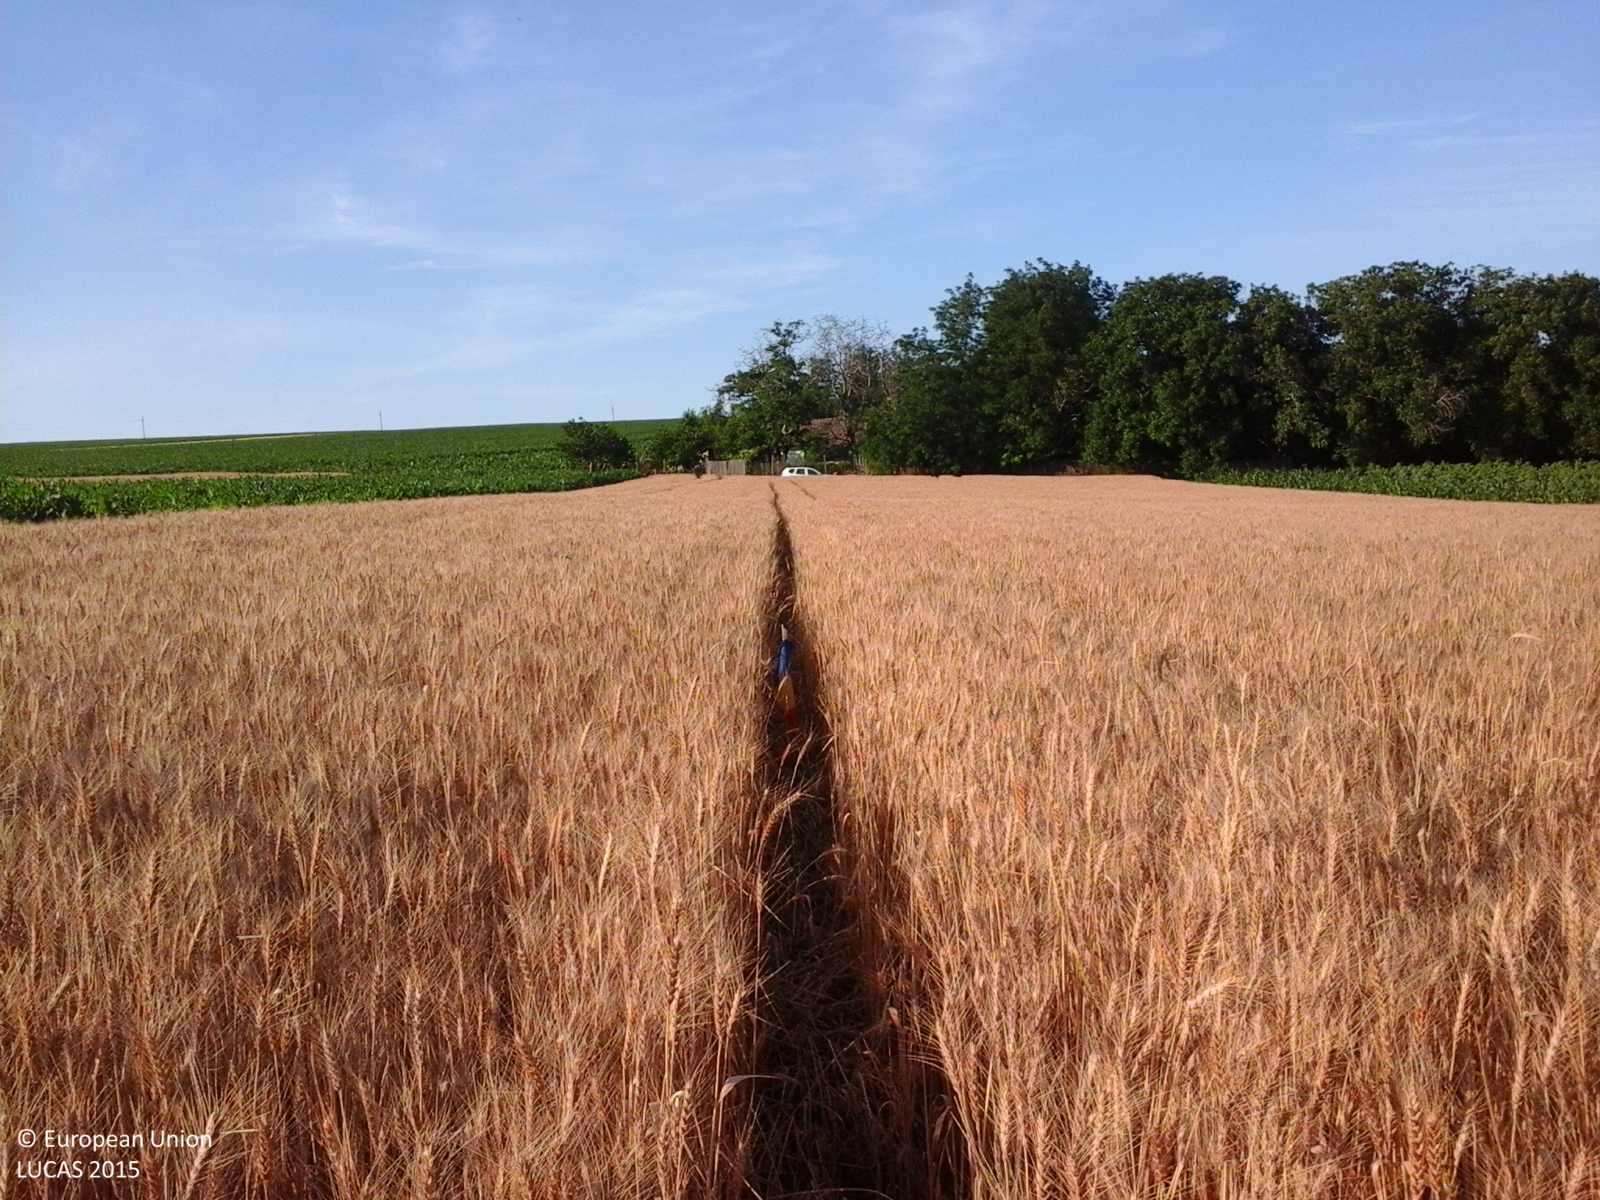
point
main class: Cropland
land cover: Common wheat
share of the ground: > 75 %
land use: Agriculture (excluding fallow land and kitchen gardens)
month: June
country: RO
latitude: 47.4104
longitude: 27.0817
